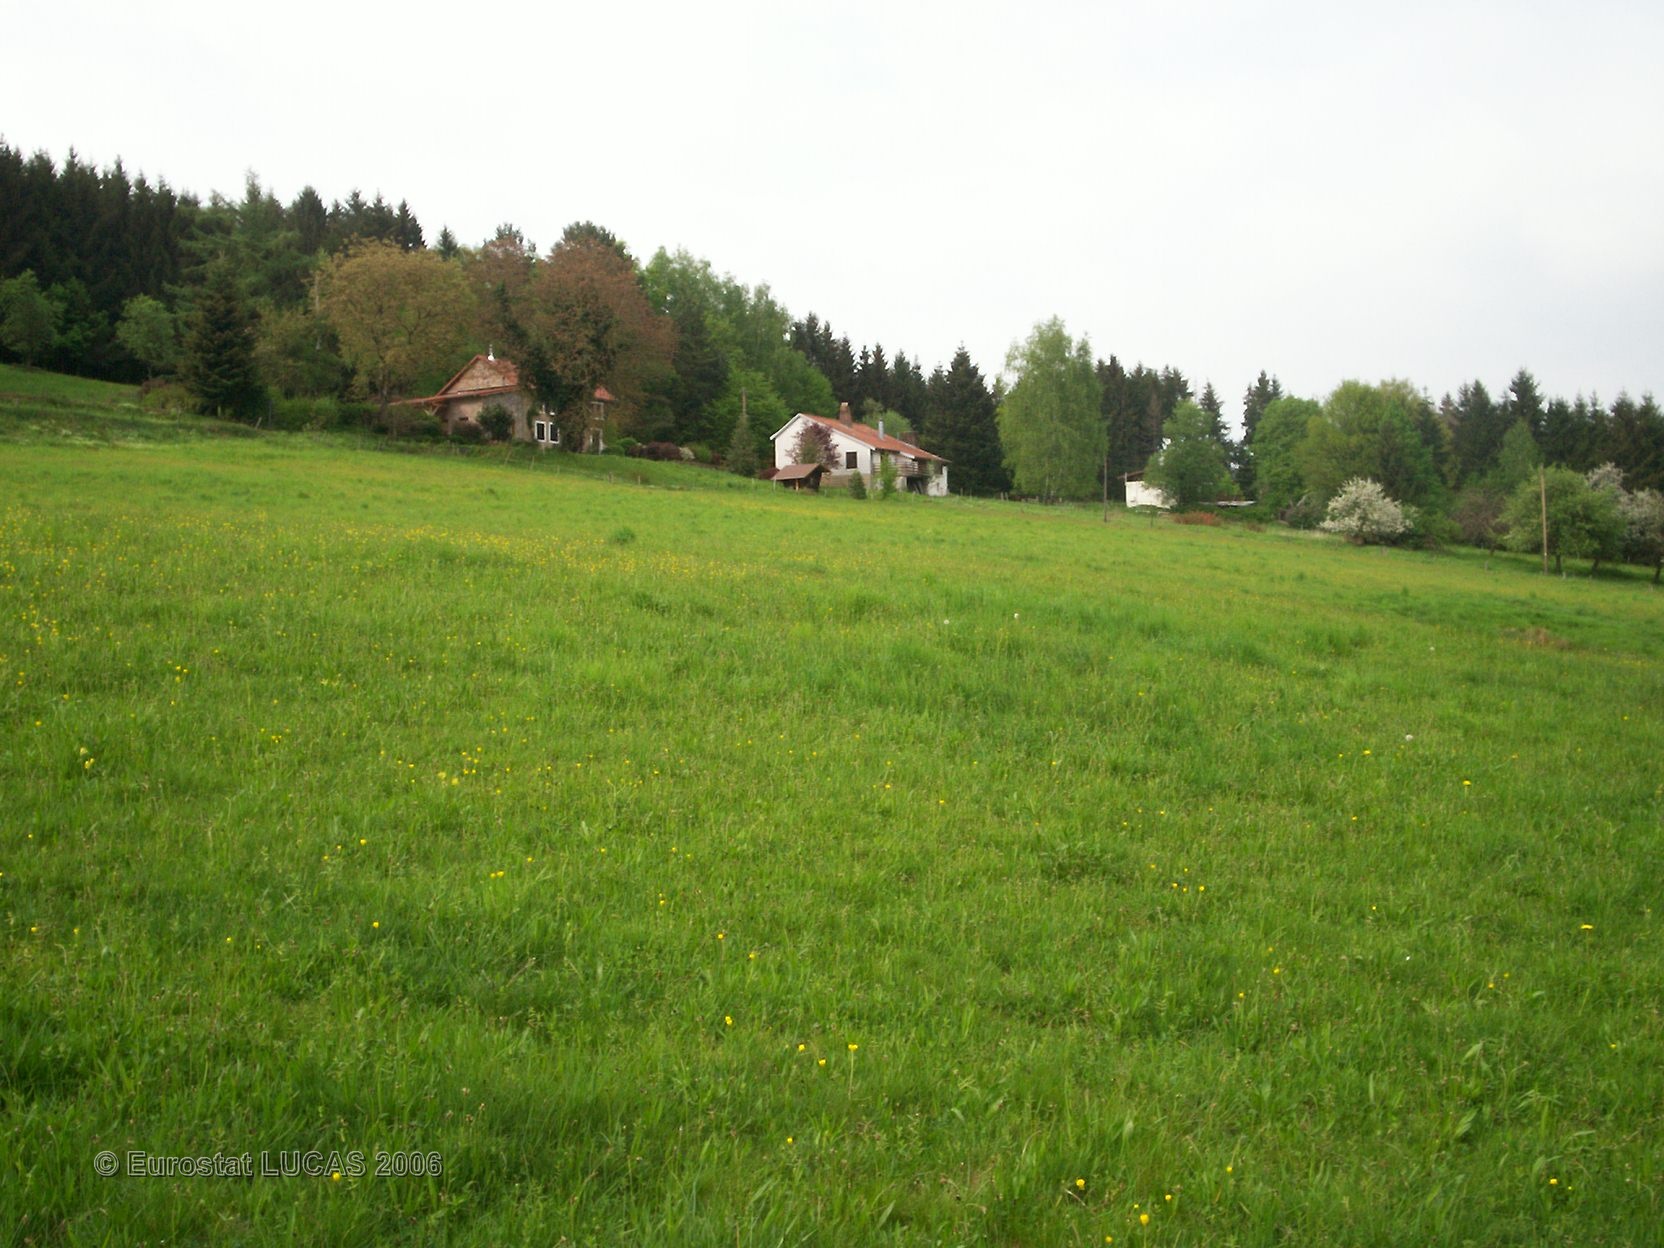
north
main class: Grassland
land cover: Grassland without tree/shrub cover
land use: Agriculture (excluding fallow land and kitchen gardens)
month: May
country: FR
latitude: 48.5970
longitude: 7.0040
